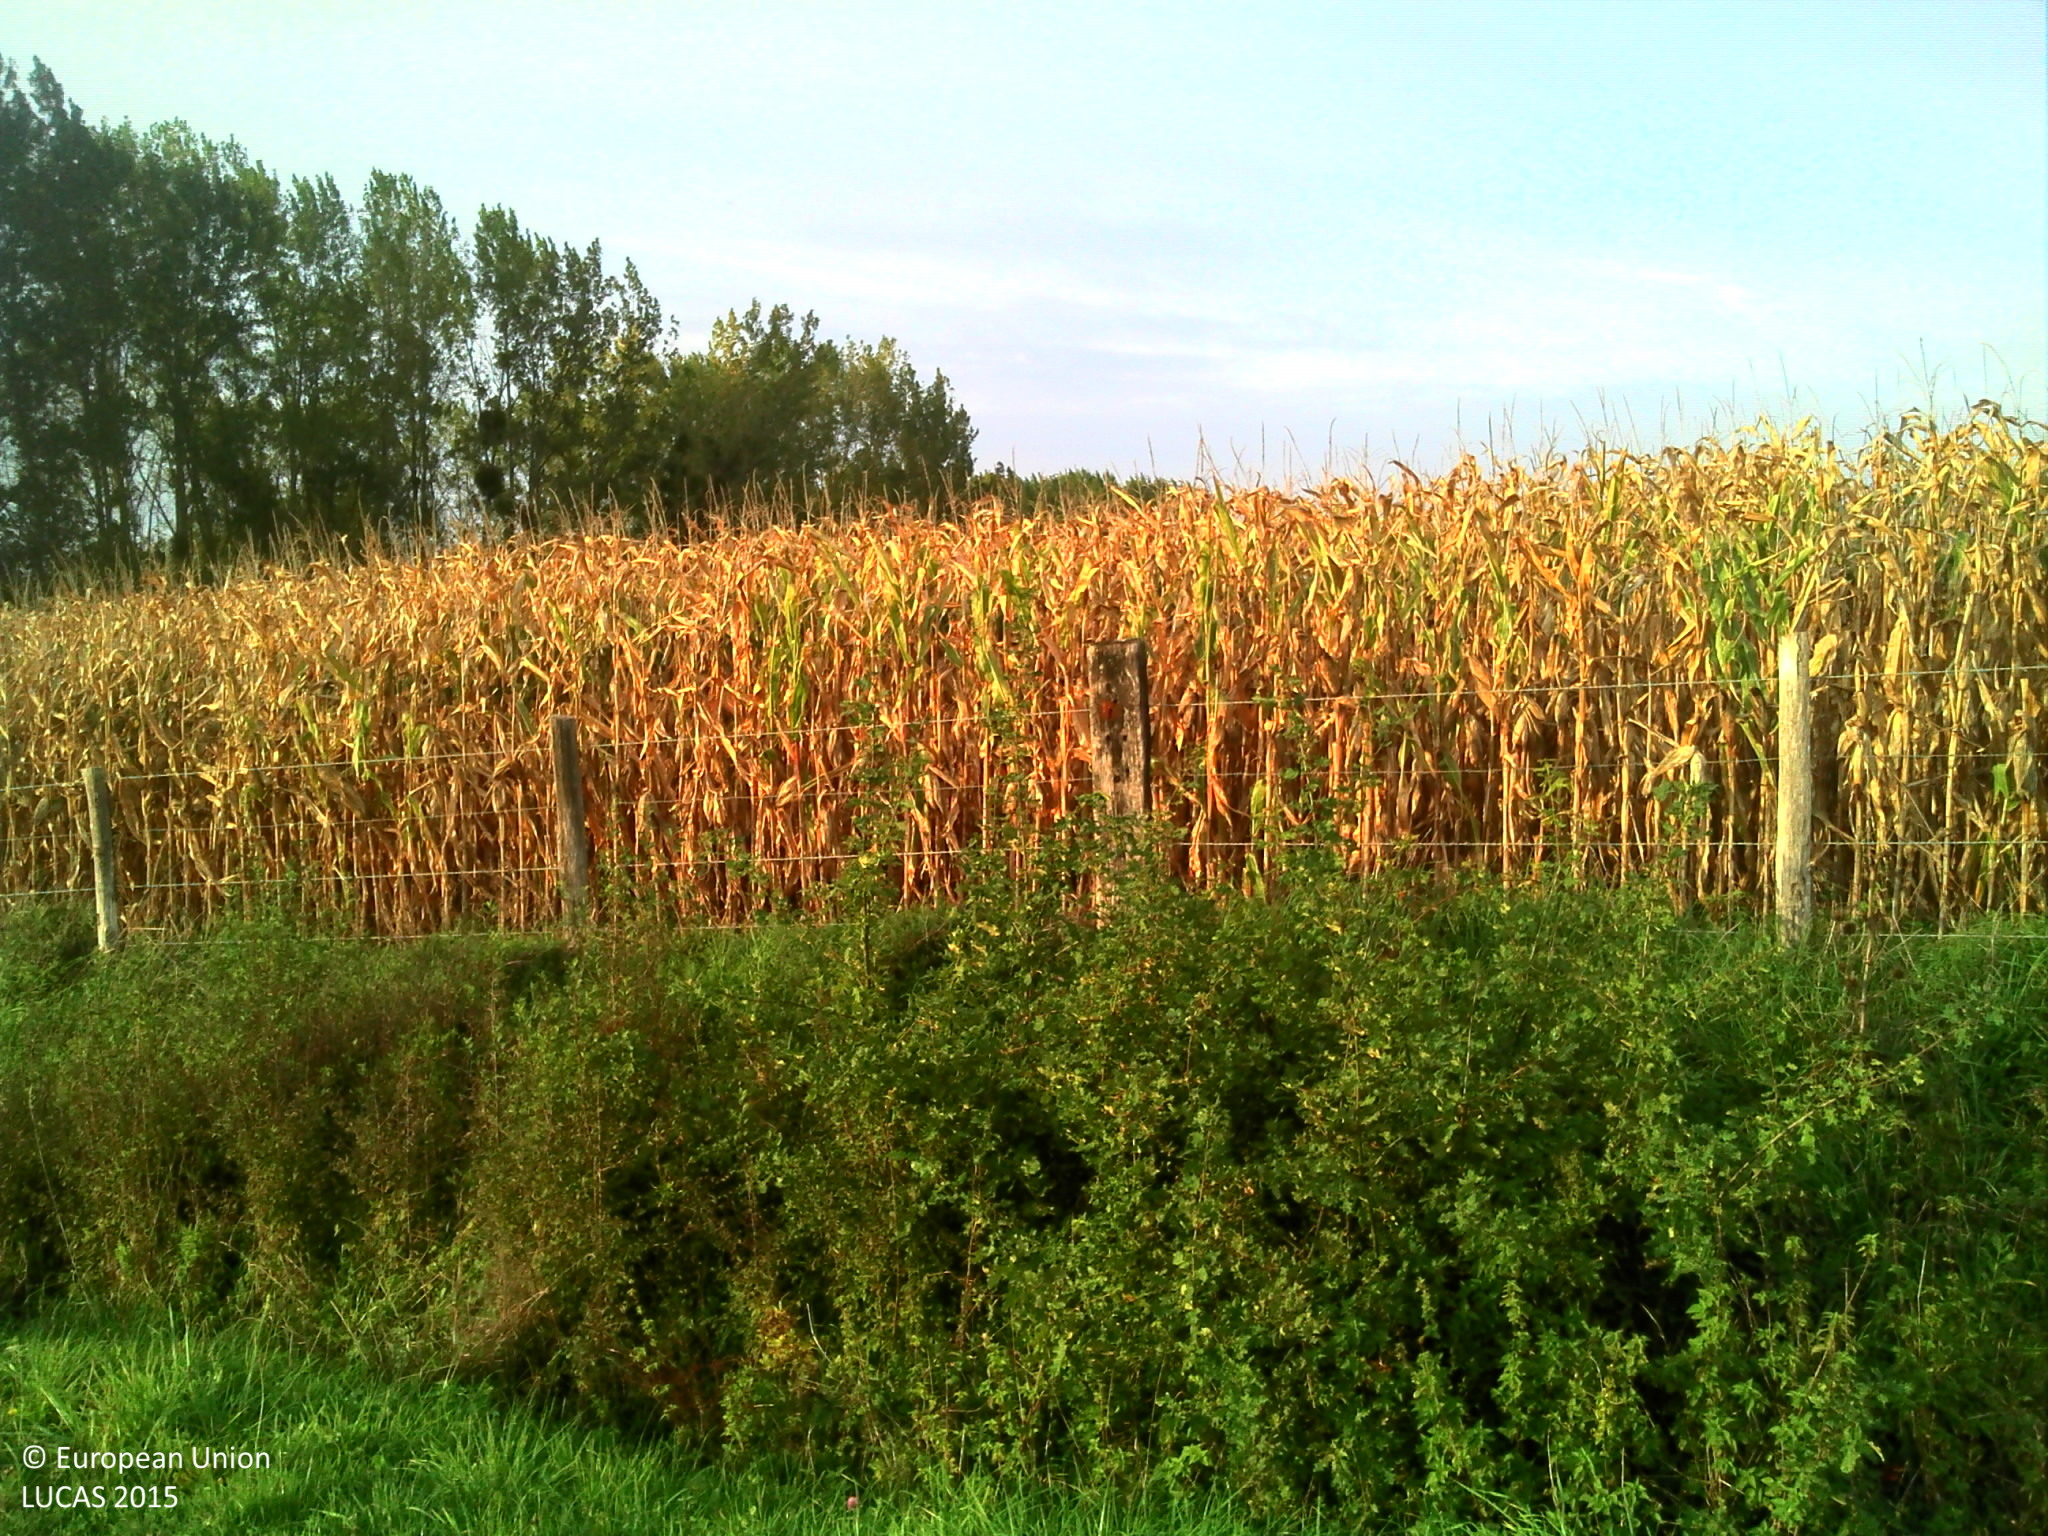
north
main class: Cropland
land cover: Maize
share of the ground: > 75 %
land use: Agriculture (excluding fallow land and kitchen gardens)
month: October
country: FR
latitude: 47.1033
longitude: -1.2243
